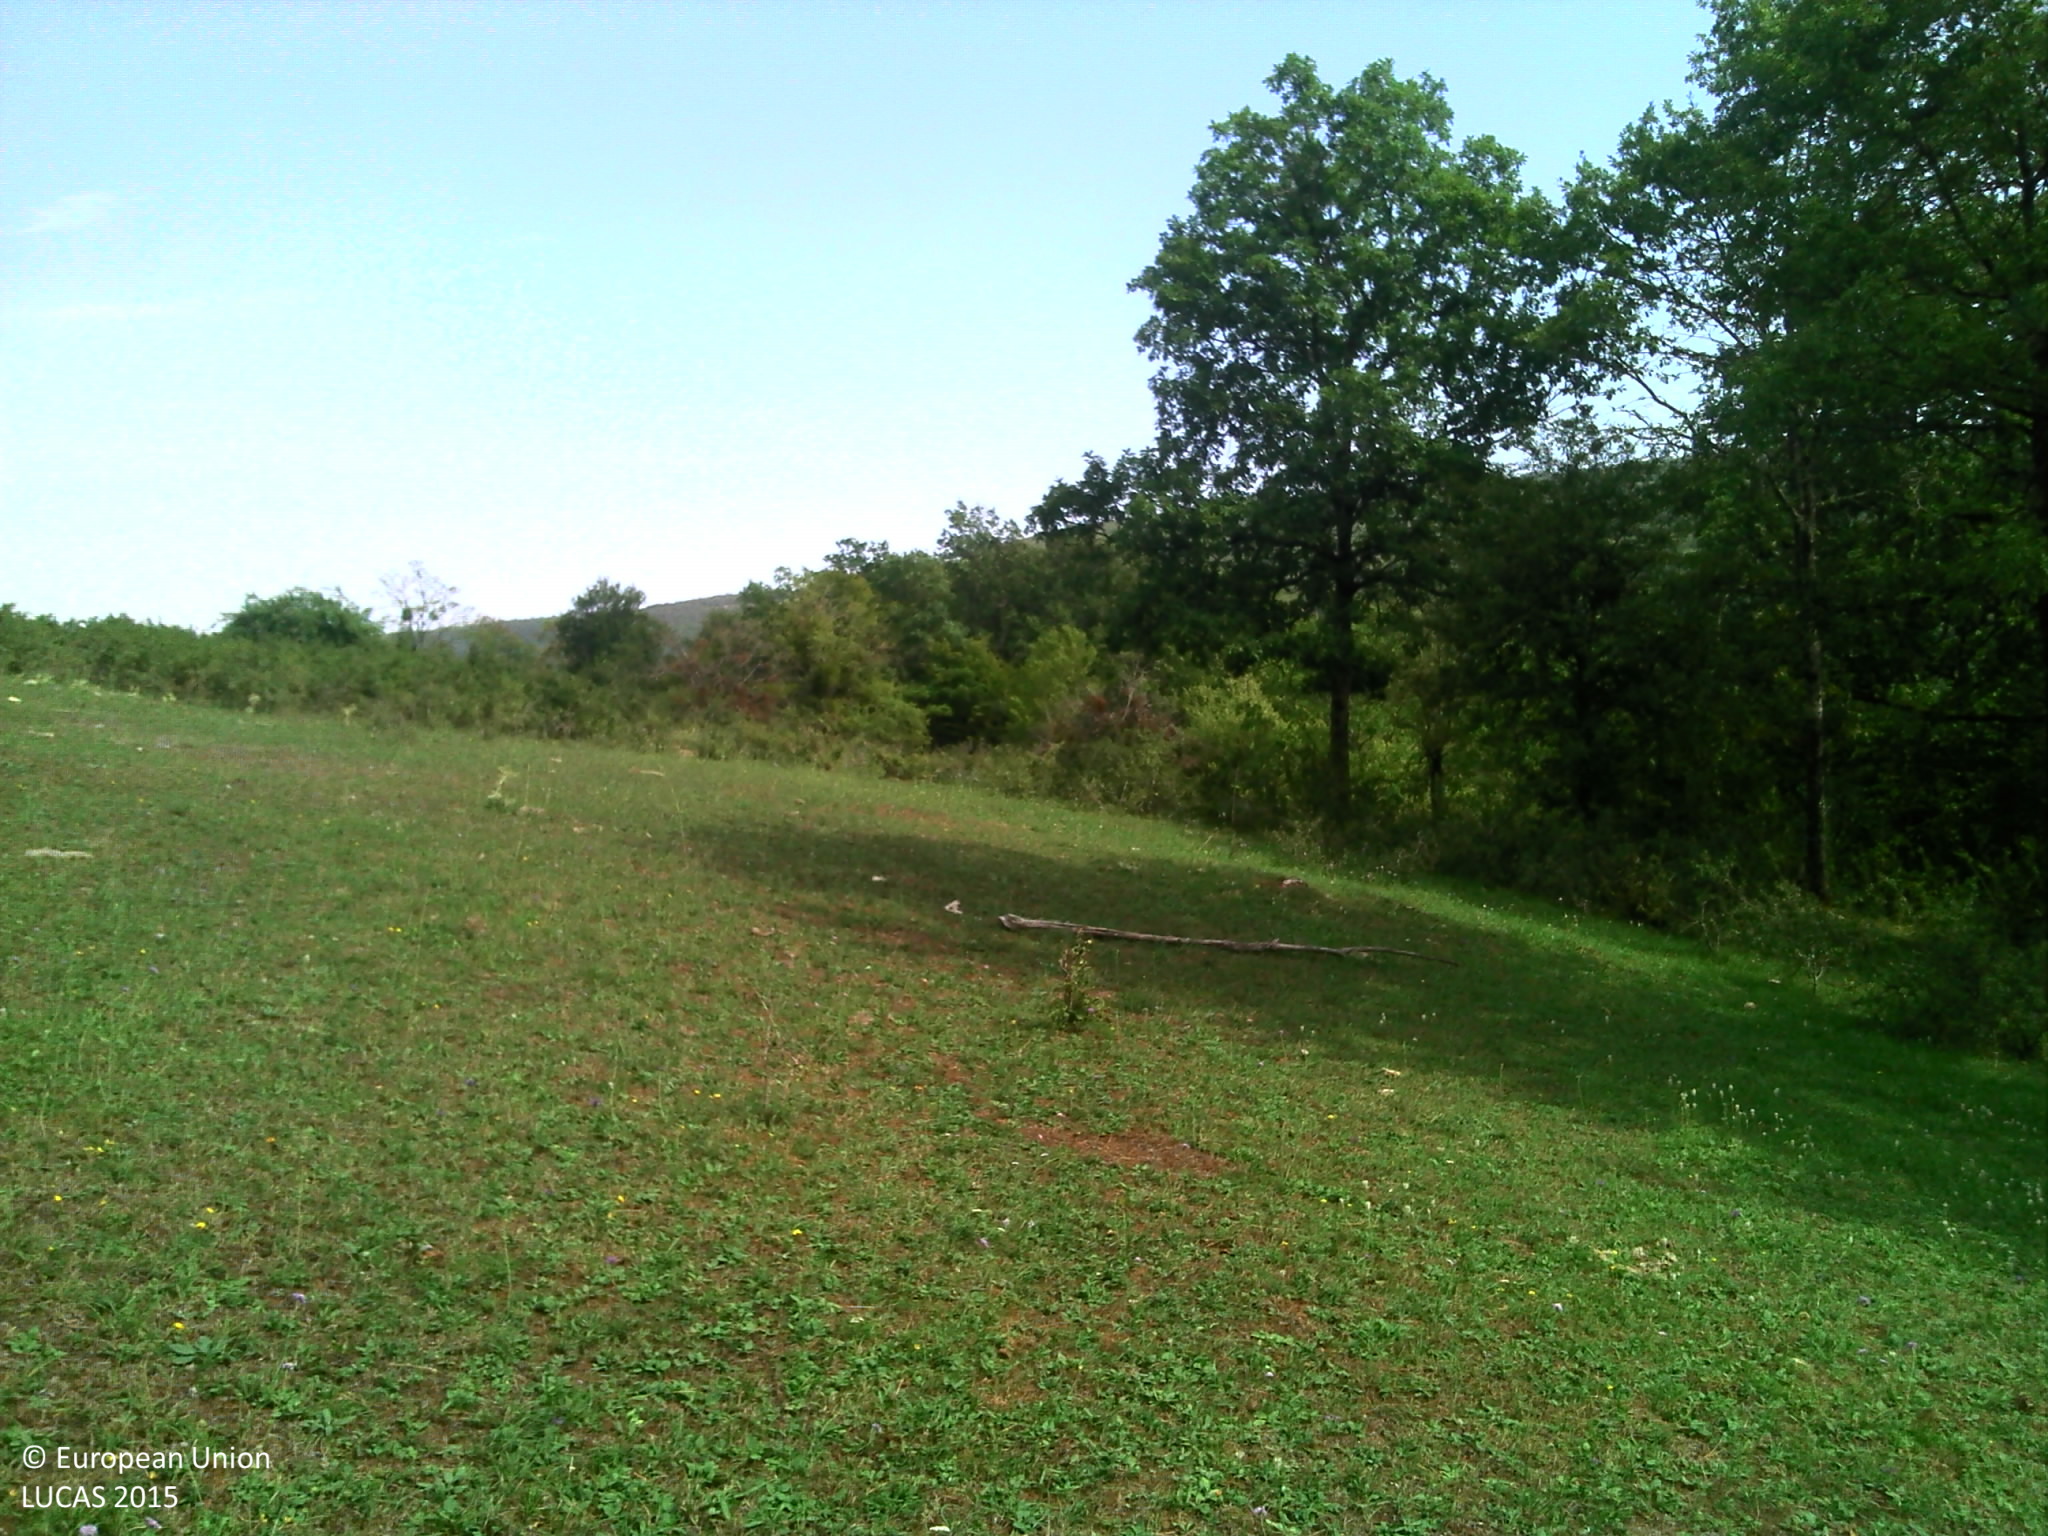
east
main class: Grassland
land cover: Grassland without tree/shrub cover
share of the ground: > 75 %
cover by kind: herbaceous plants 100 %
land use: Agriculture (excluding fallow land and kitchen gardens)
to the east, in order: Grassland without tree/shrub cover; Shrubland without tree cover; Grassland with sparse tree/shrub cover; Shrubland without tree cover; Grassland with sparse tree/shrub cover; Shrubland with sparse tree cover; Broadleaved woodland; Dry stone walls; Broadleaved woodland; Grassland without tree/shrub cover
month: August
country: FR
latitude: 47.2318
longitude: 4.7300
